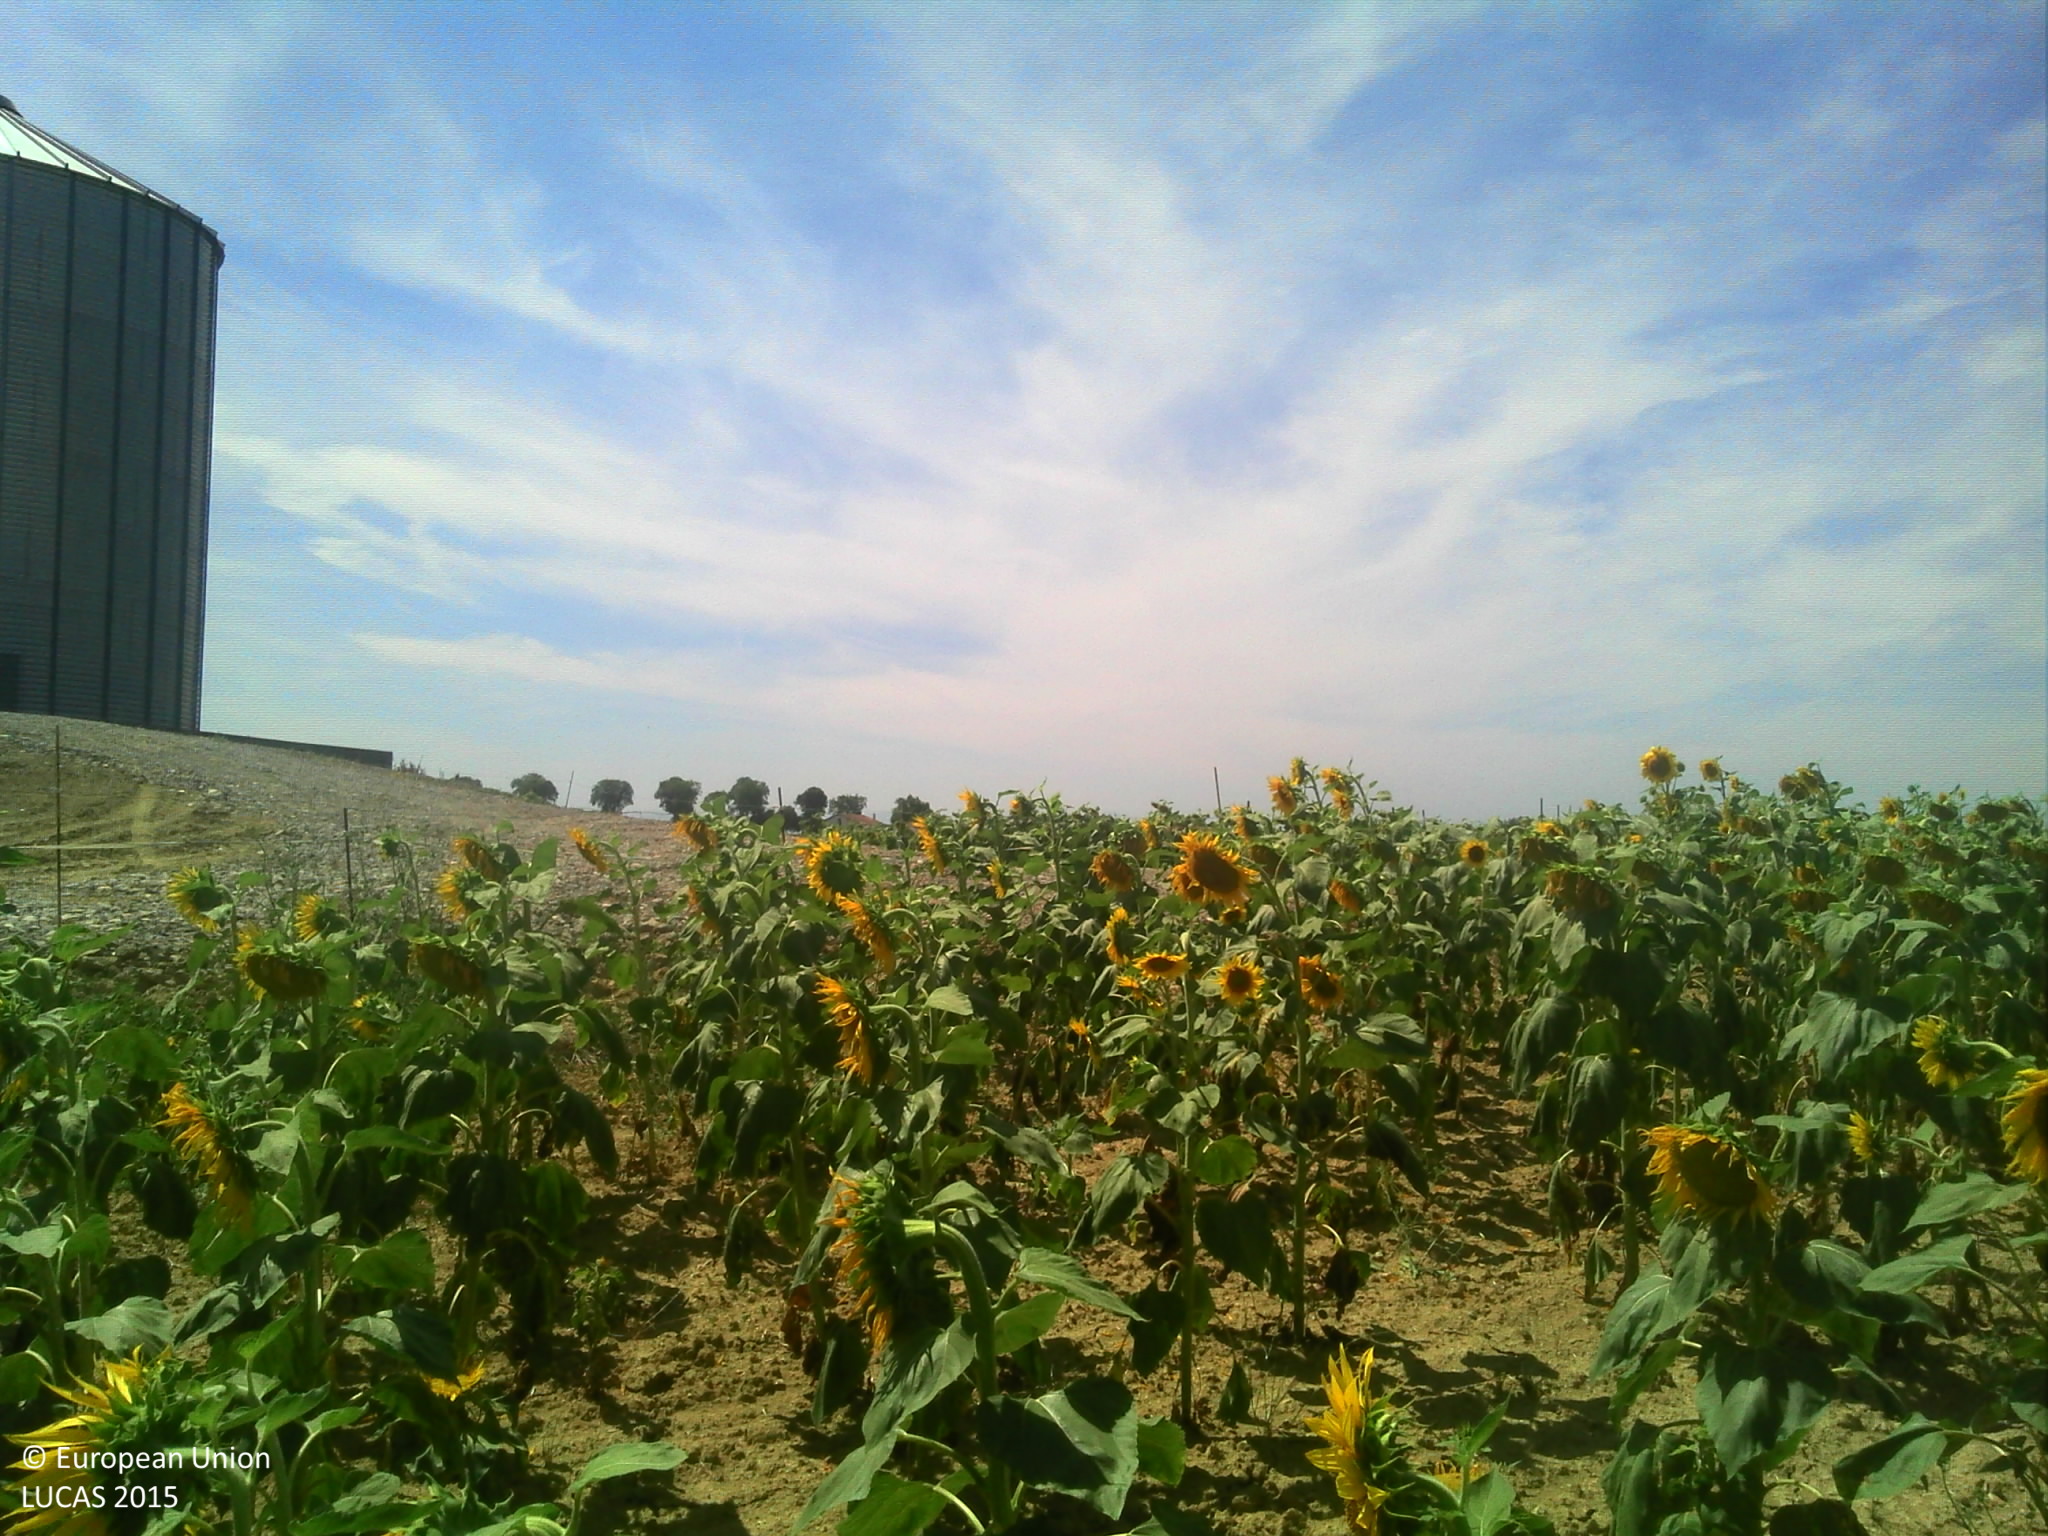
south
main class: Cropland
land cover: Sunflower
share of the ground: > 75 %
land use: Agriculture (excluding fallow land and kitchen gardens)
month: July
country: FR
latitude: 43.3565
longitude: 1.3792
